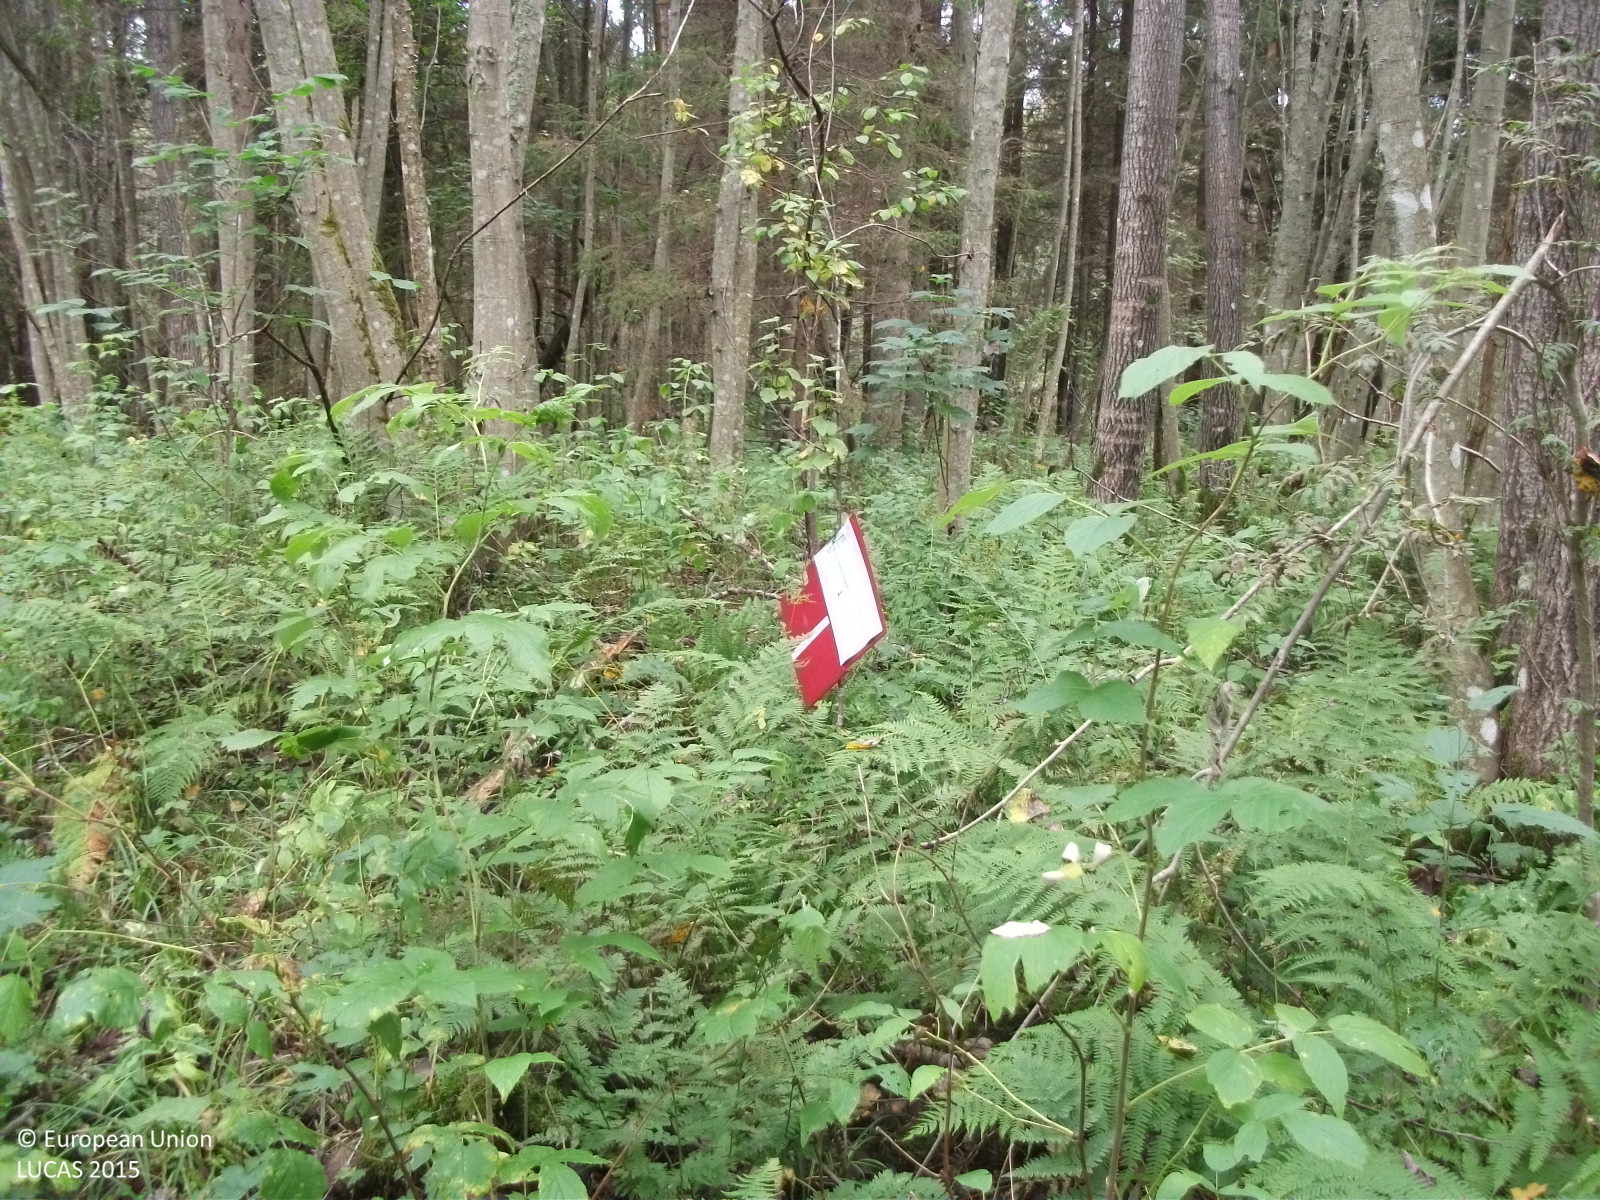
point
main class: Woodland
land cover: Spruce dominated mixed woodland
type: hemiboreal forest and nemoral coniferous forest and mixed broadleaved-coniferous forest
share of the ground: > 75 %
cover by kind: broadleaved forest trees 70 %, coniferous forest trees 25 %, herbaceous plants 5 %
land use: Forestry
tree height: > 5 m
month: September
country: LV
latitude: 57.6803
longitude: 24.5297
